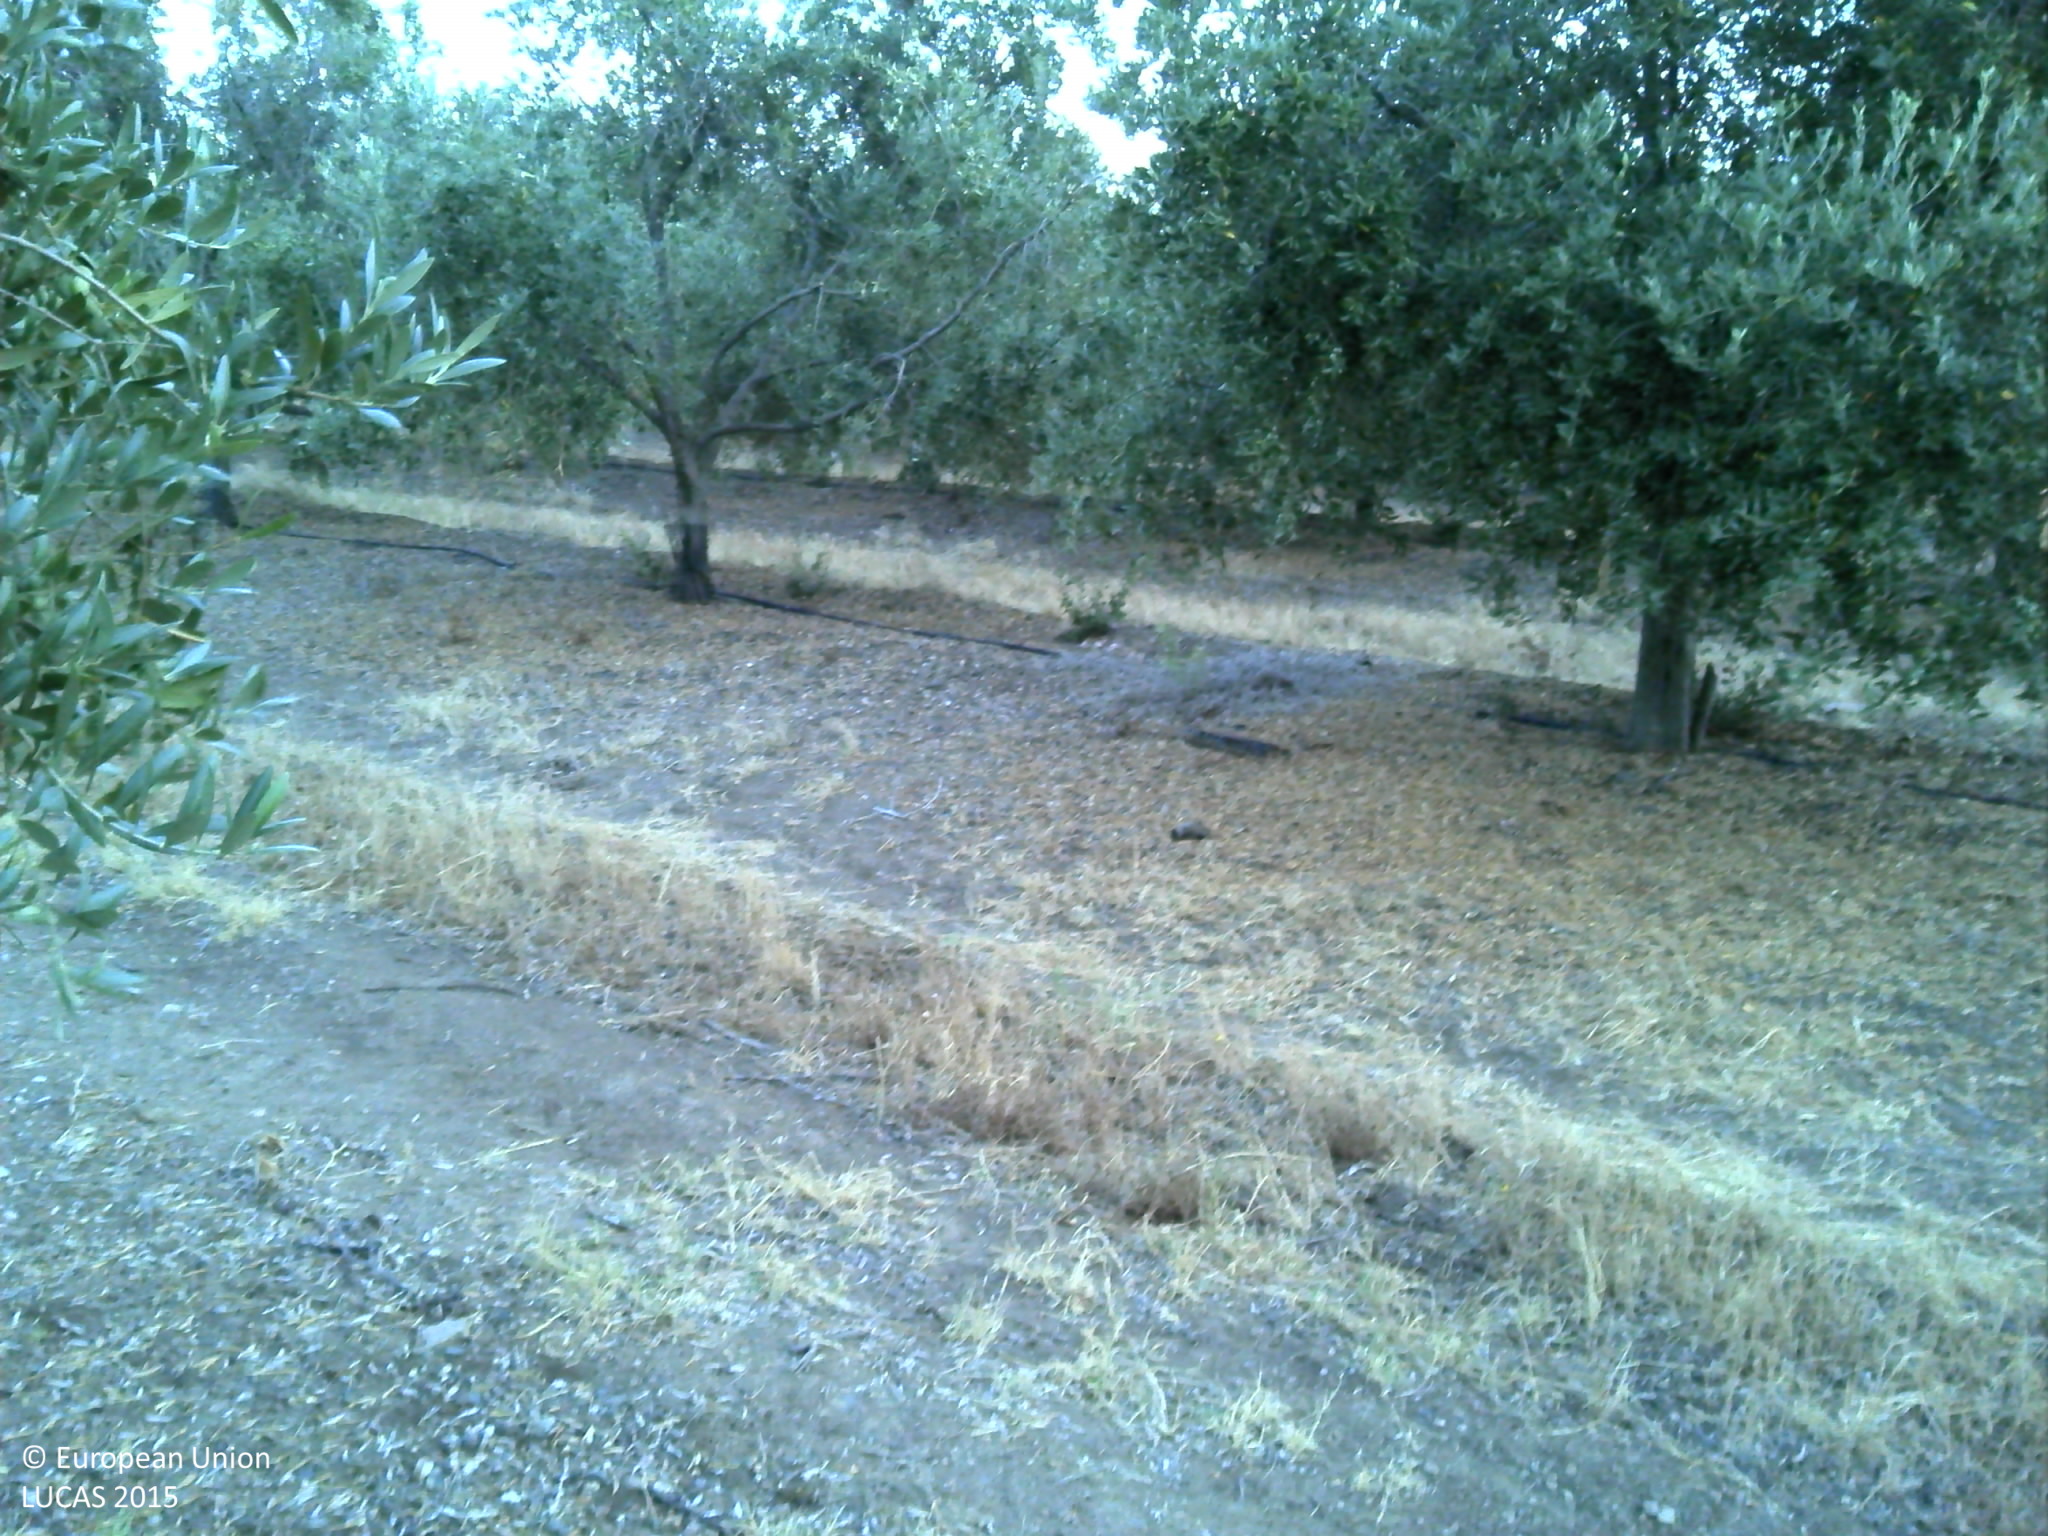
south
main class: Cropland
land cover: Olive groves
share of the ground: > 75 %
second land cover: Grassland without tree/shrub cover
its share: < 10 %
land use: Agriculture (excluding fallow land and kitchen gardens)
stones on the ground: < 10 %
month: July
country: PT
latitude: 38.0832
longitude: -7.7315
